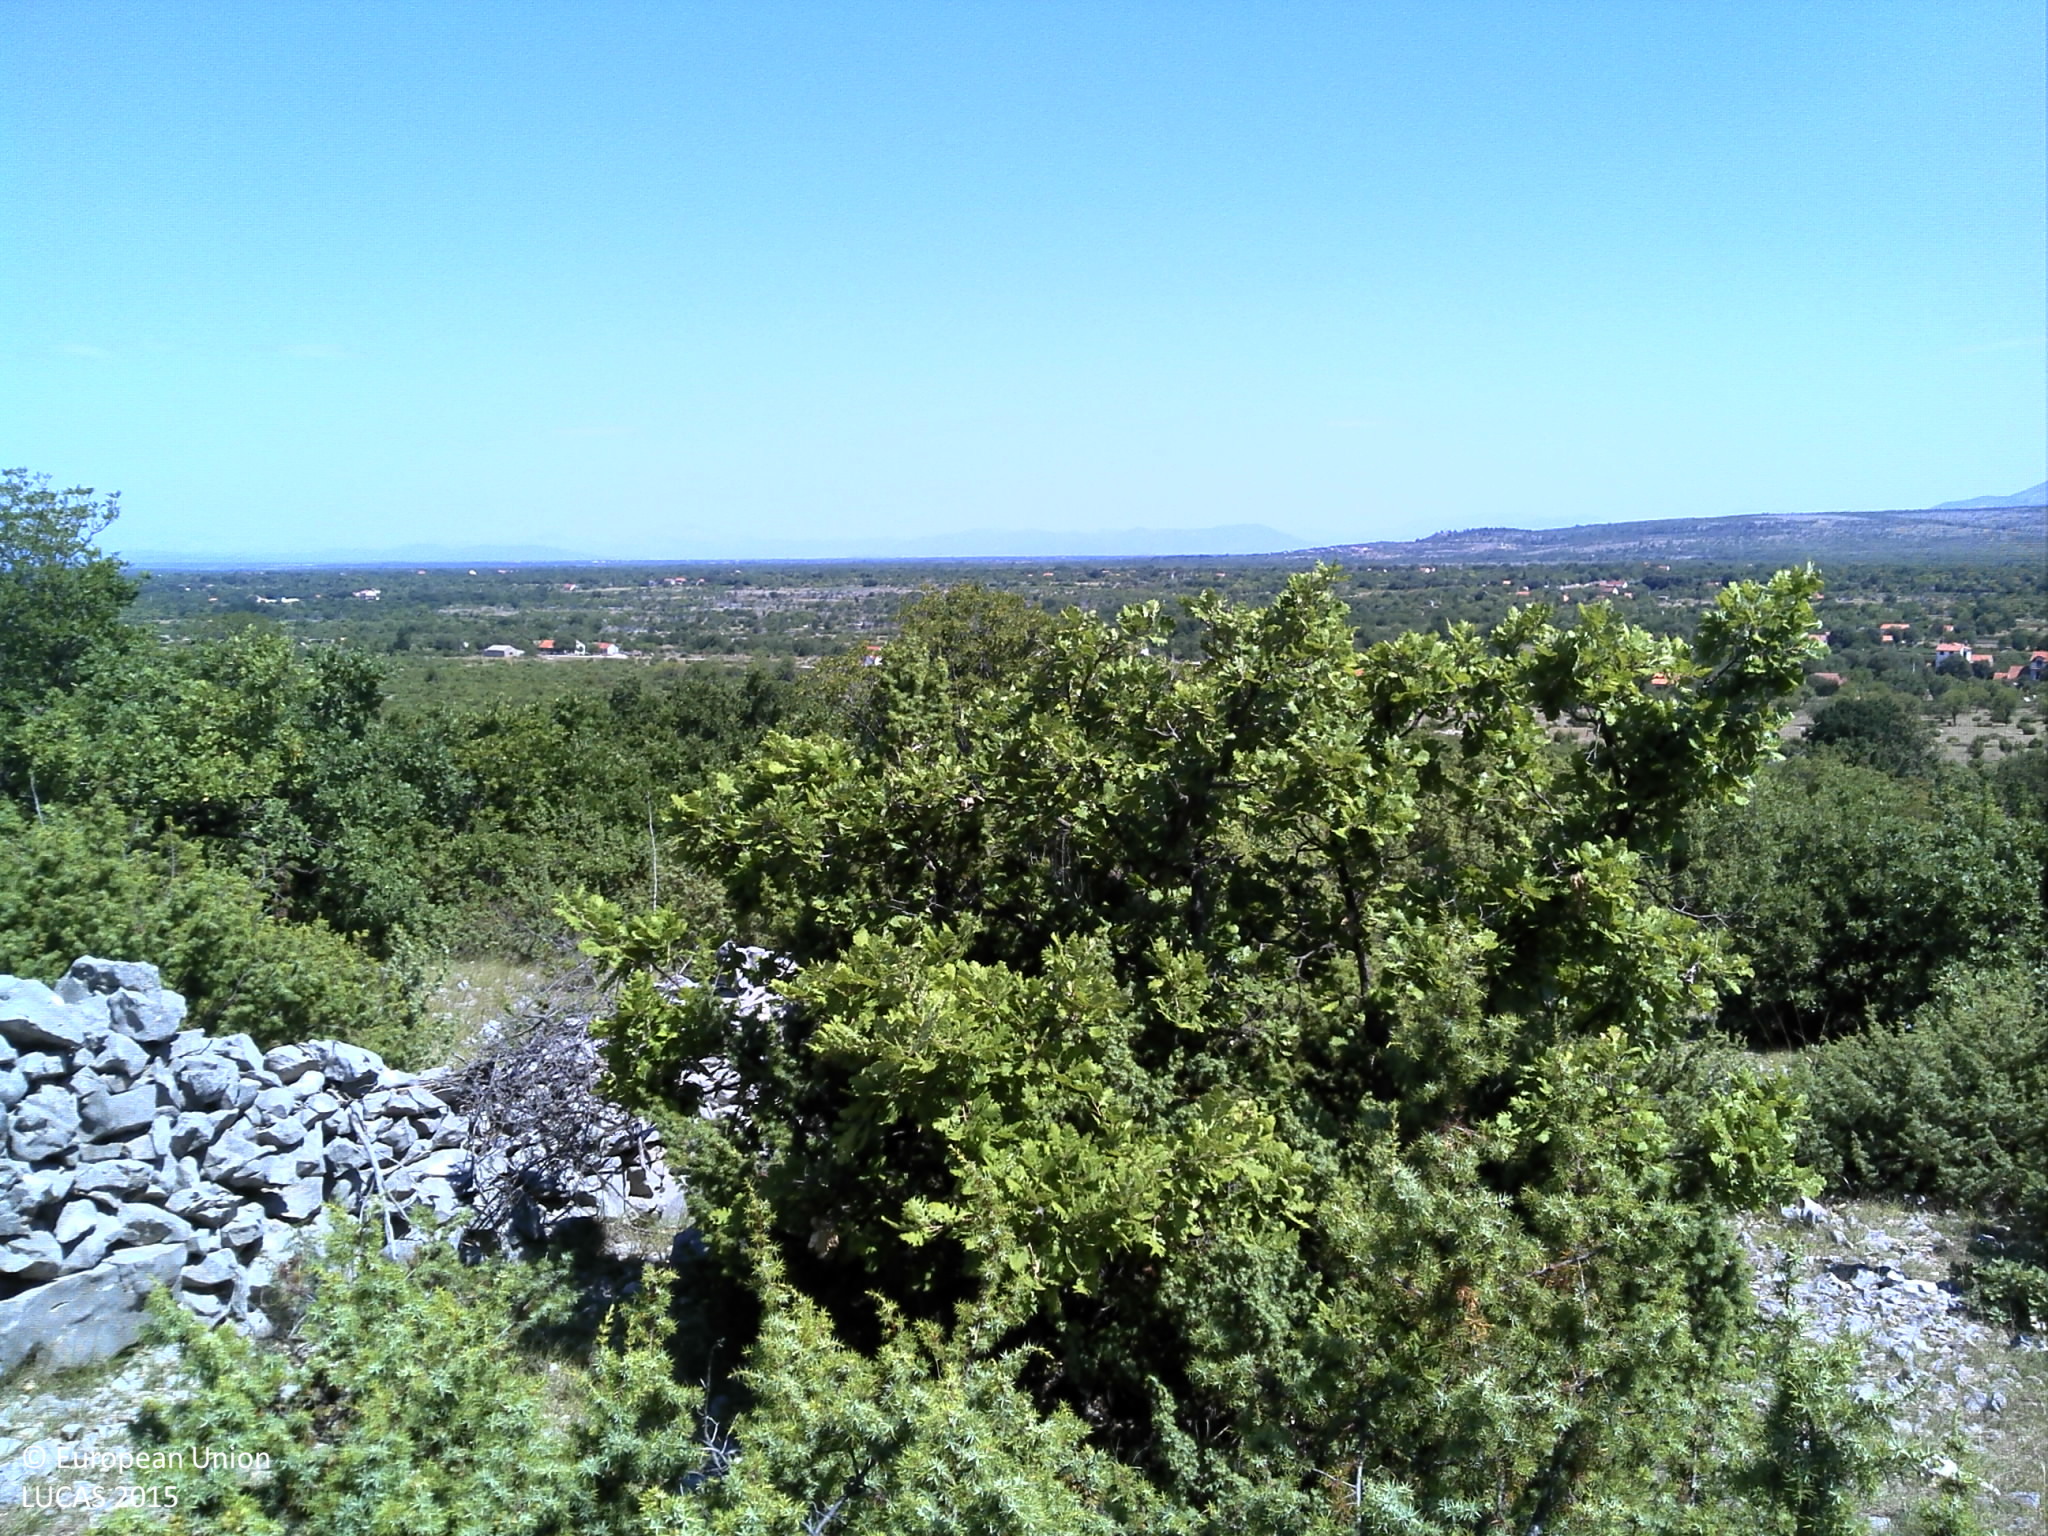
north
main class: Shrubland
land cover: Shrubland with sparse tree cover
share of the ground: 50 - 75 %
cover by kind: shrubs 60 %, unconsolidated bare surface 25 %, consolidated bare surface 10 %, broadleaved forest trees 5 %
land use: Semi-natural and natural areas not in use
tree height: < 5 m
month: July
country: HR
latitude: 43.7572
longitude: 16.0648
